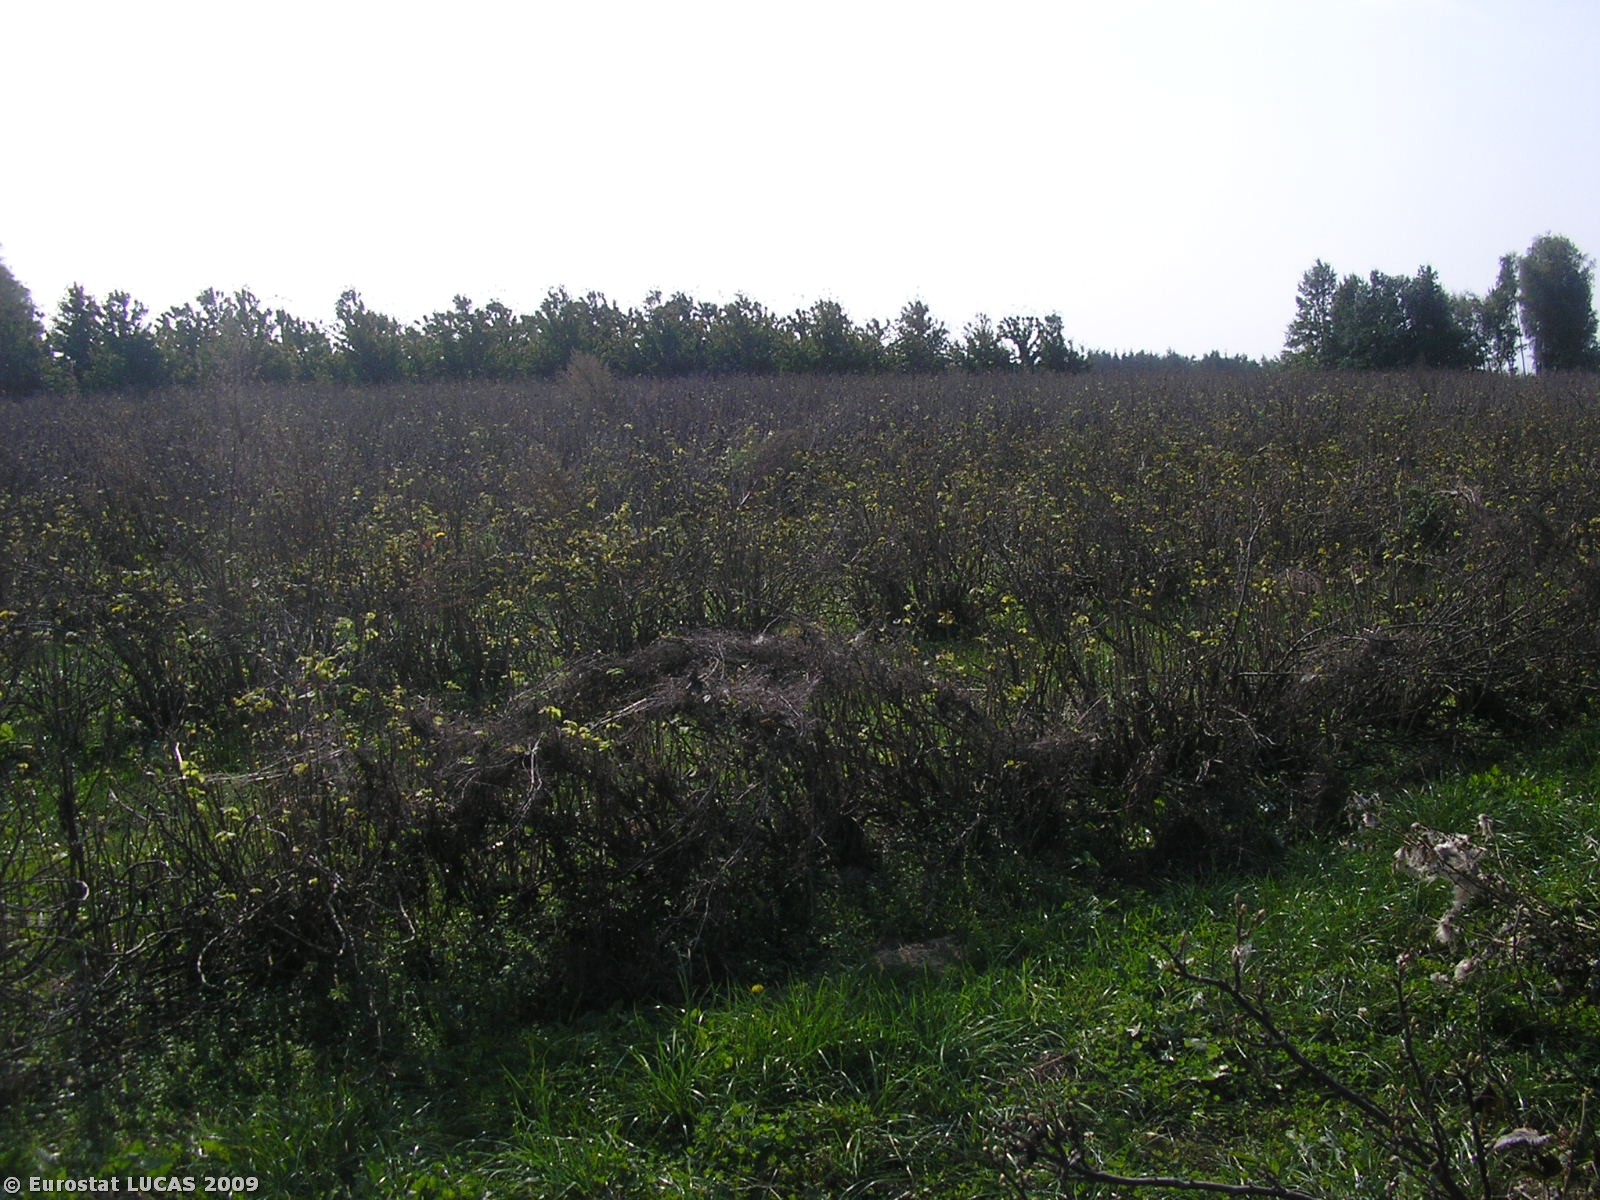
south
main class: Cropland
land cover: Apple fruit
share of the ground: 25 - 50 %
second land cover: Grassland with sparse tree/shrub cover
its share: > 75 %
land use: Agriculture (excluding fallow land and kitchen gardens)
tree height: < 5 m
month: September
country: PL
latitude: 51.9286
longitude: 20.7005
